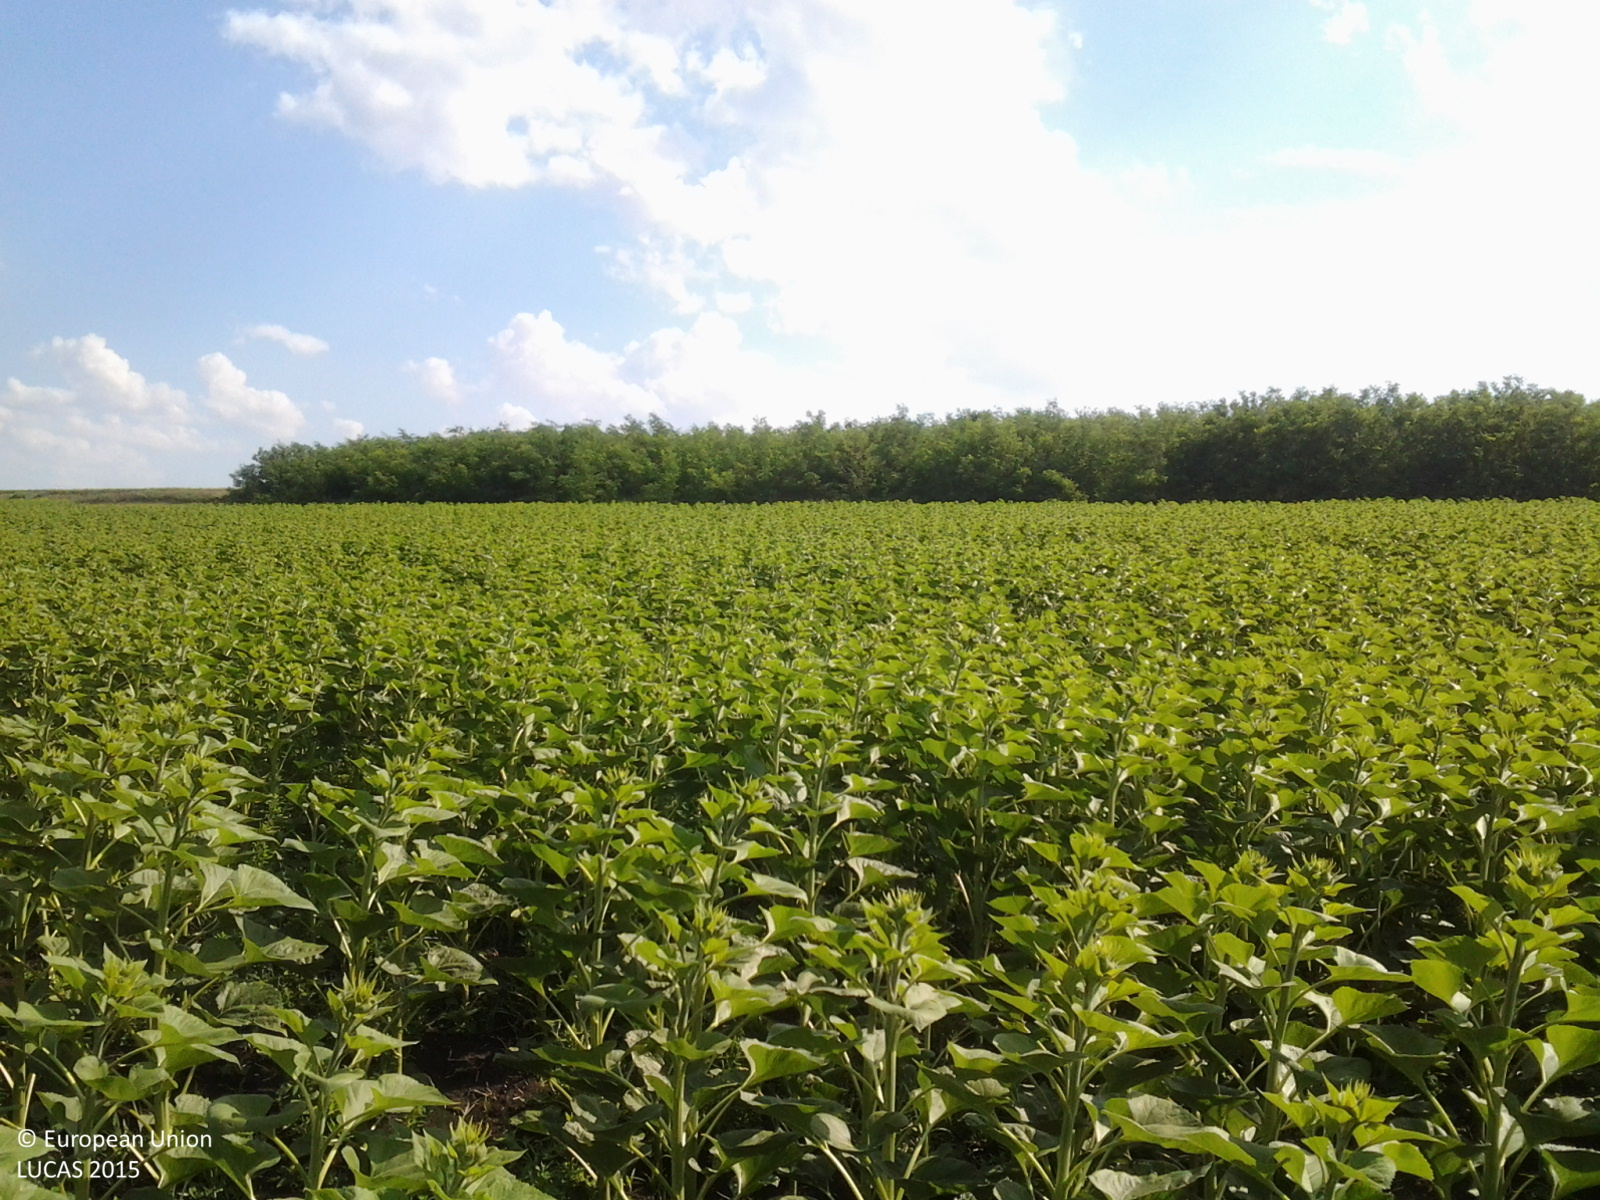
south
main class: Cropland
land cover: Sunflower
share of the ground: 50 - 75 %
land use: Agriculture (excluding fallow land and kitchen gardens)
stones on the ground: < 10 %
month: June
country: RO
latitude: 47.5233
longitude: 27.0651
